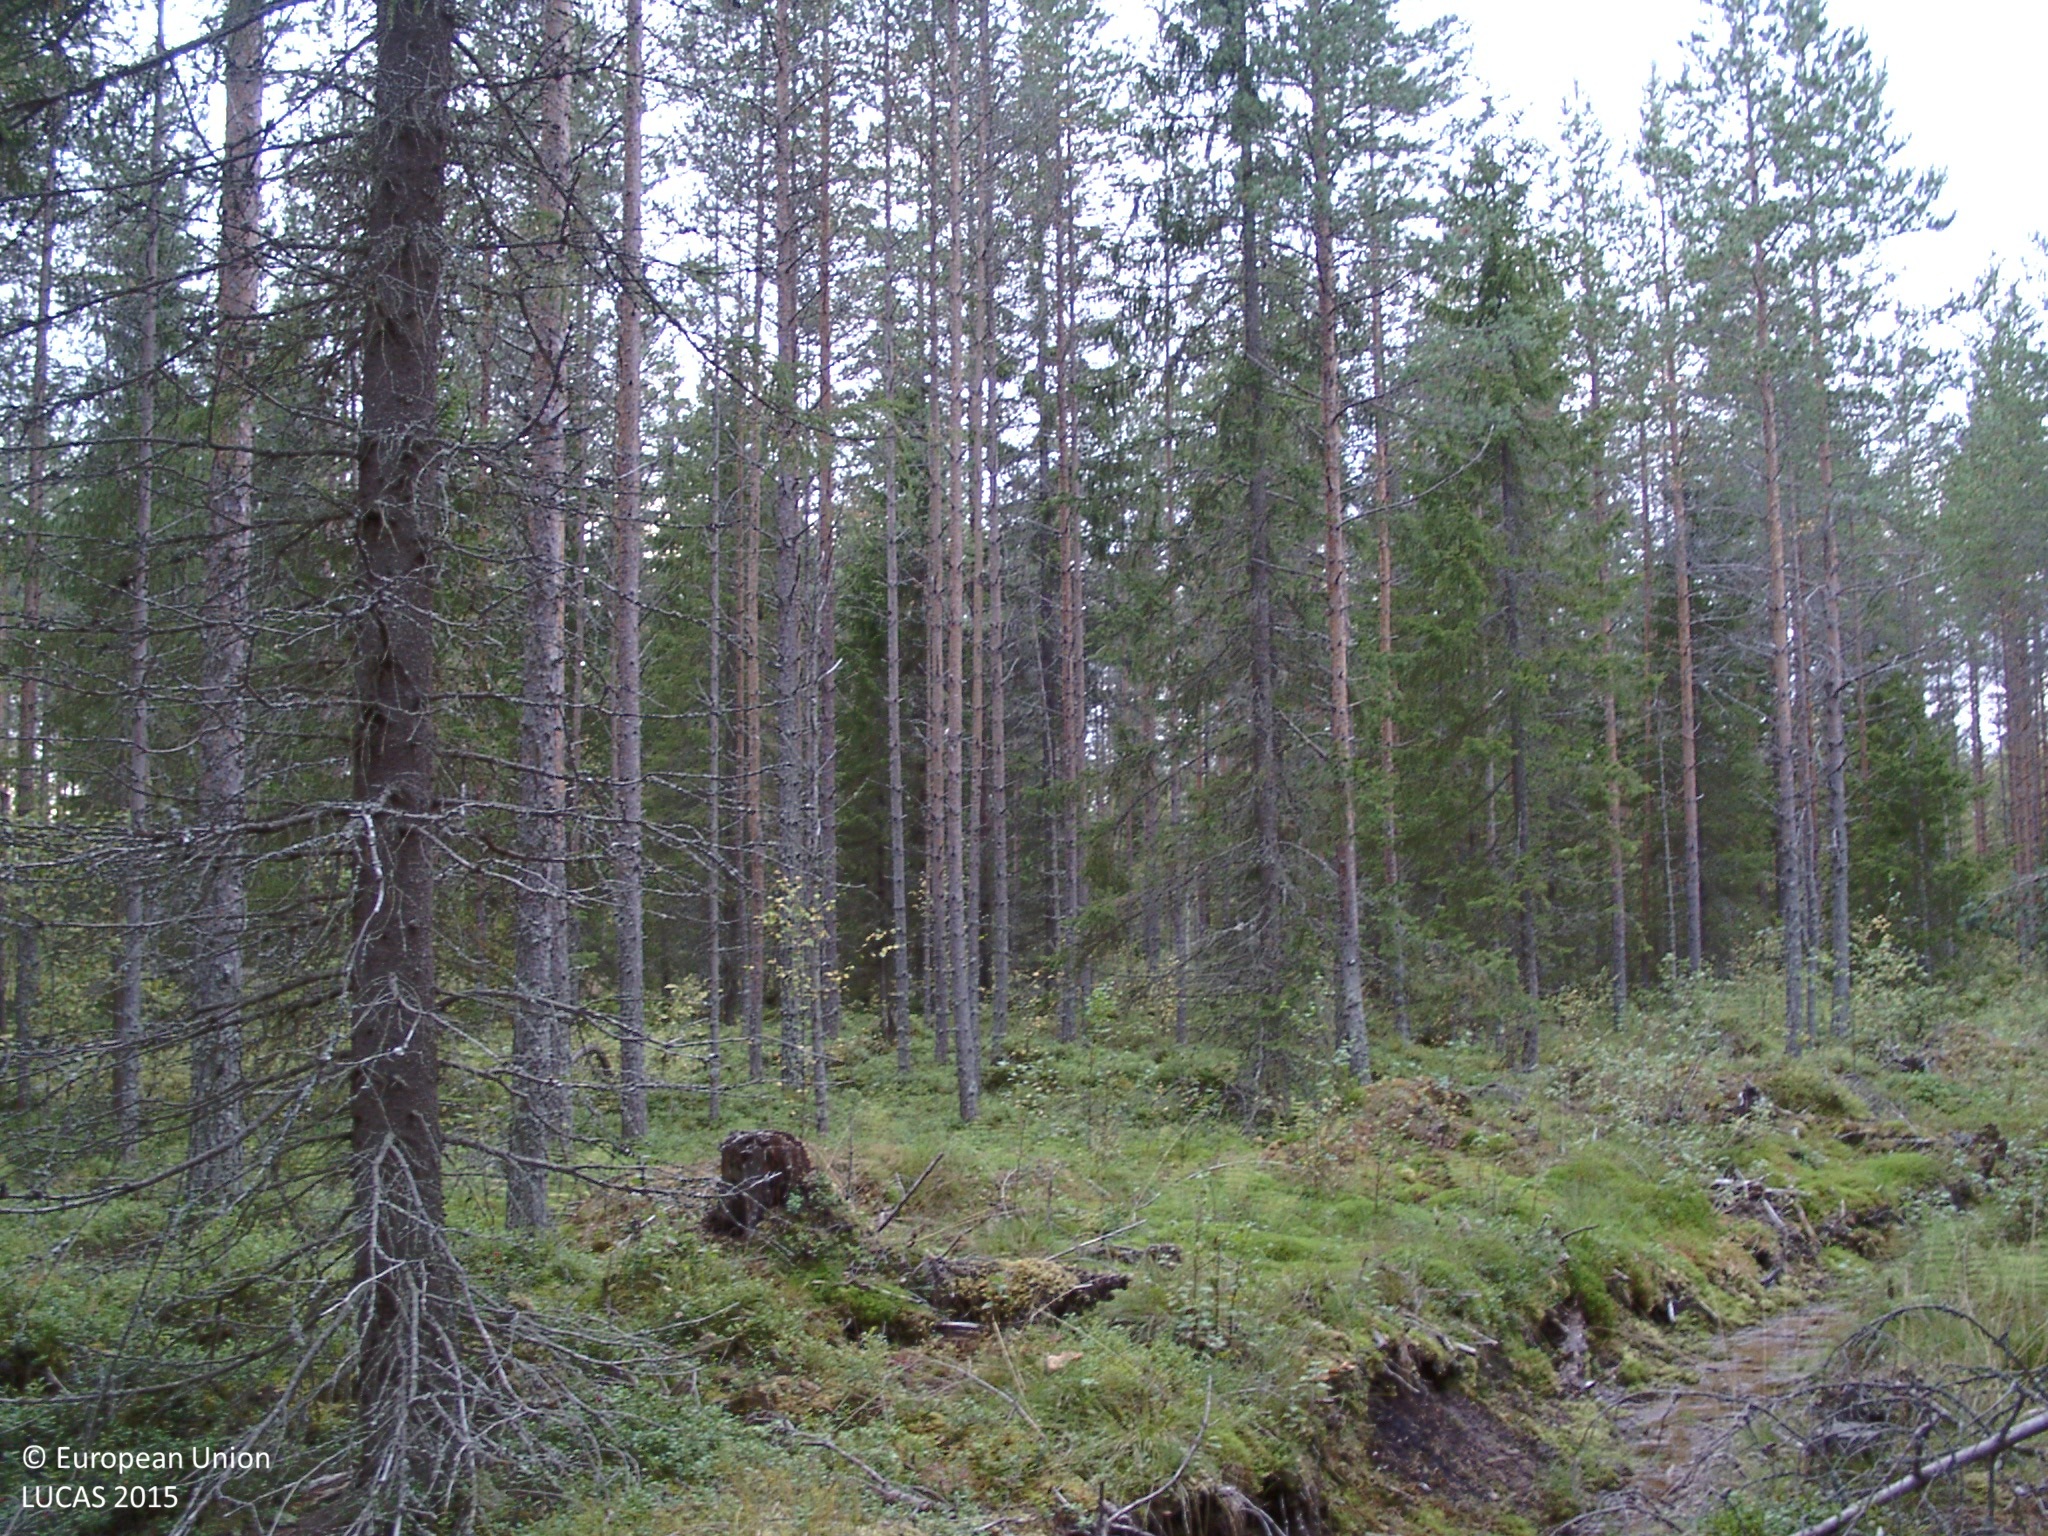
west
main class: Woodland
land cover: Other coniferous woodland
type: boreal forest
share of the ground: 50 - 75 %
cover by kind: coniferous forest trees 60 %, shrubs 20 %, lichens and mosses 10 %, broadleaved forest trees 5 %, unconsolidated bare surface 5 %
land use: Forestry
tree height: > 5 m
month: September
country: FI
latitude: 62.8764
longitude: 25.4620
